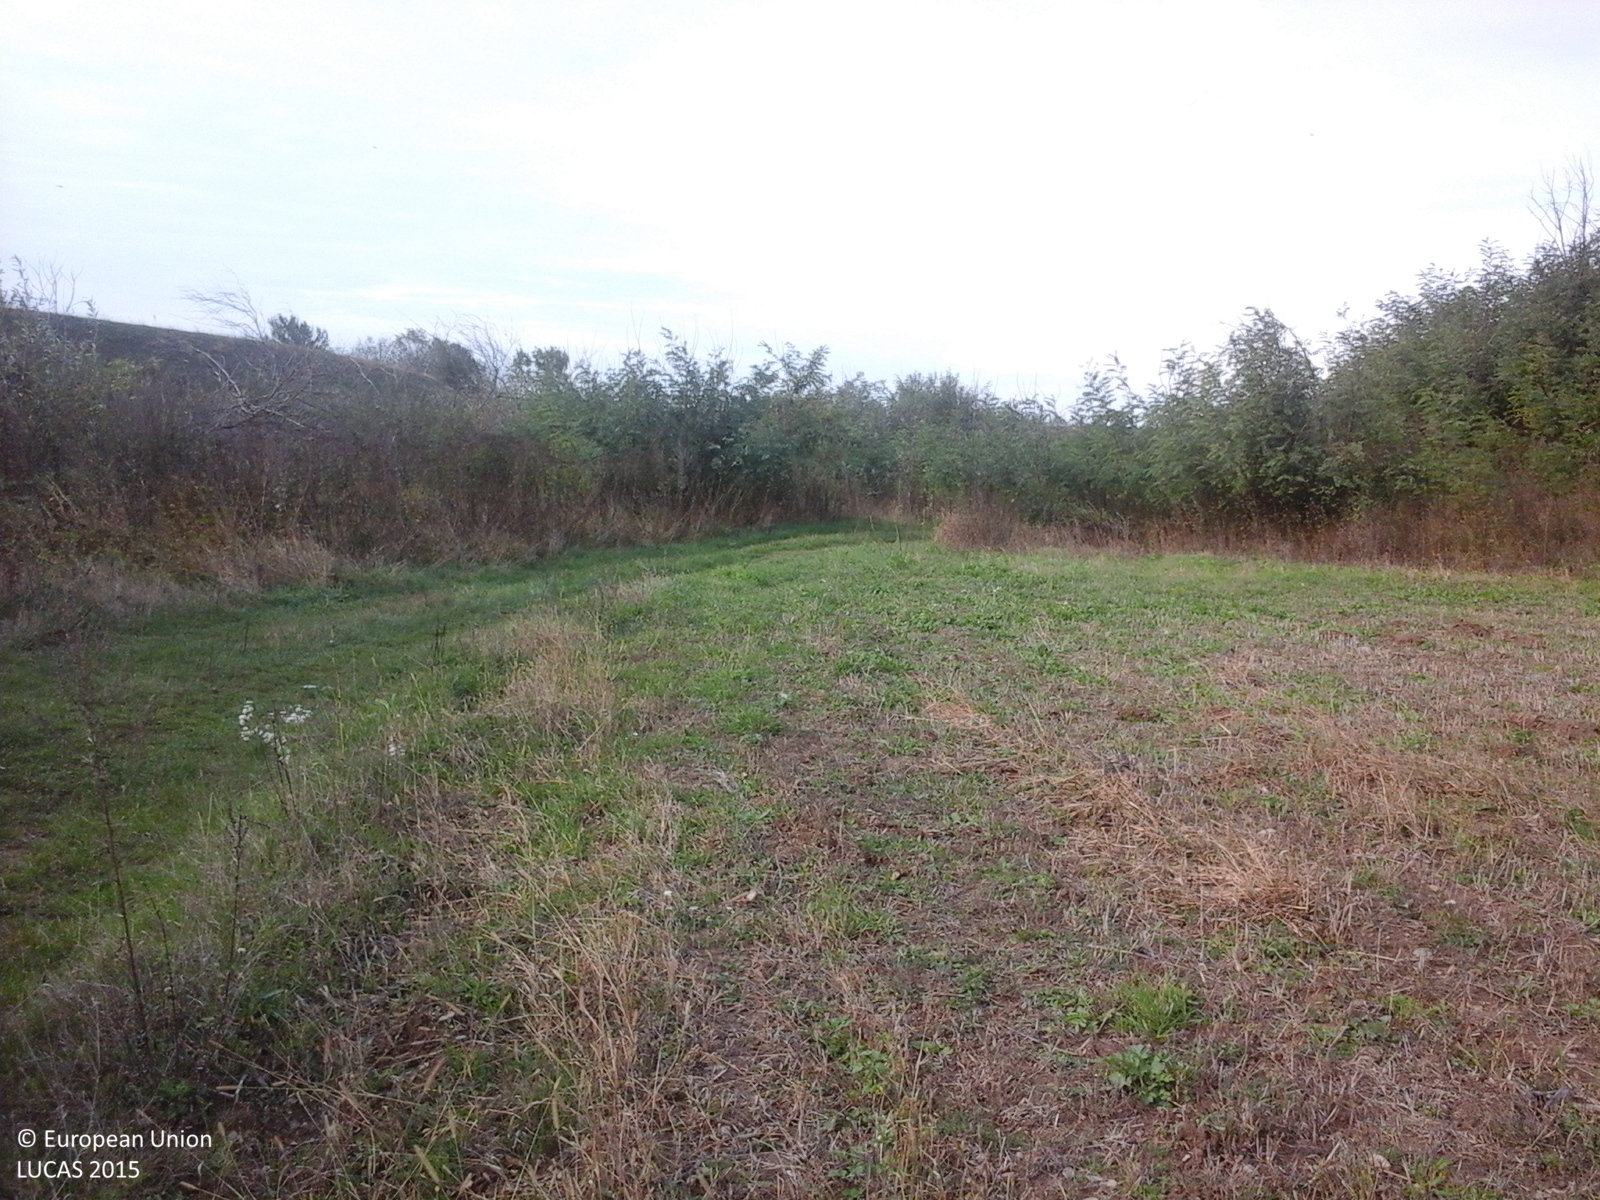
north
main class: Grassland
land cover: Grassland without tree/shrub cover
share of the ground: > 75 %
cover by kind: herbaceous plants 100 %
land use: Agriculture (excluding fallow land and kitchen gardens)
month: October
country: RO
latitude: 45.7908
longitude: 25.0542
